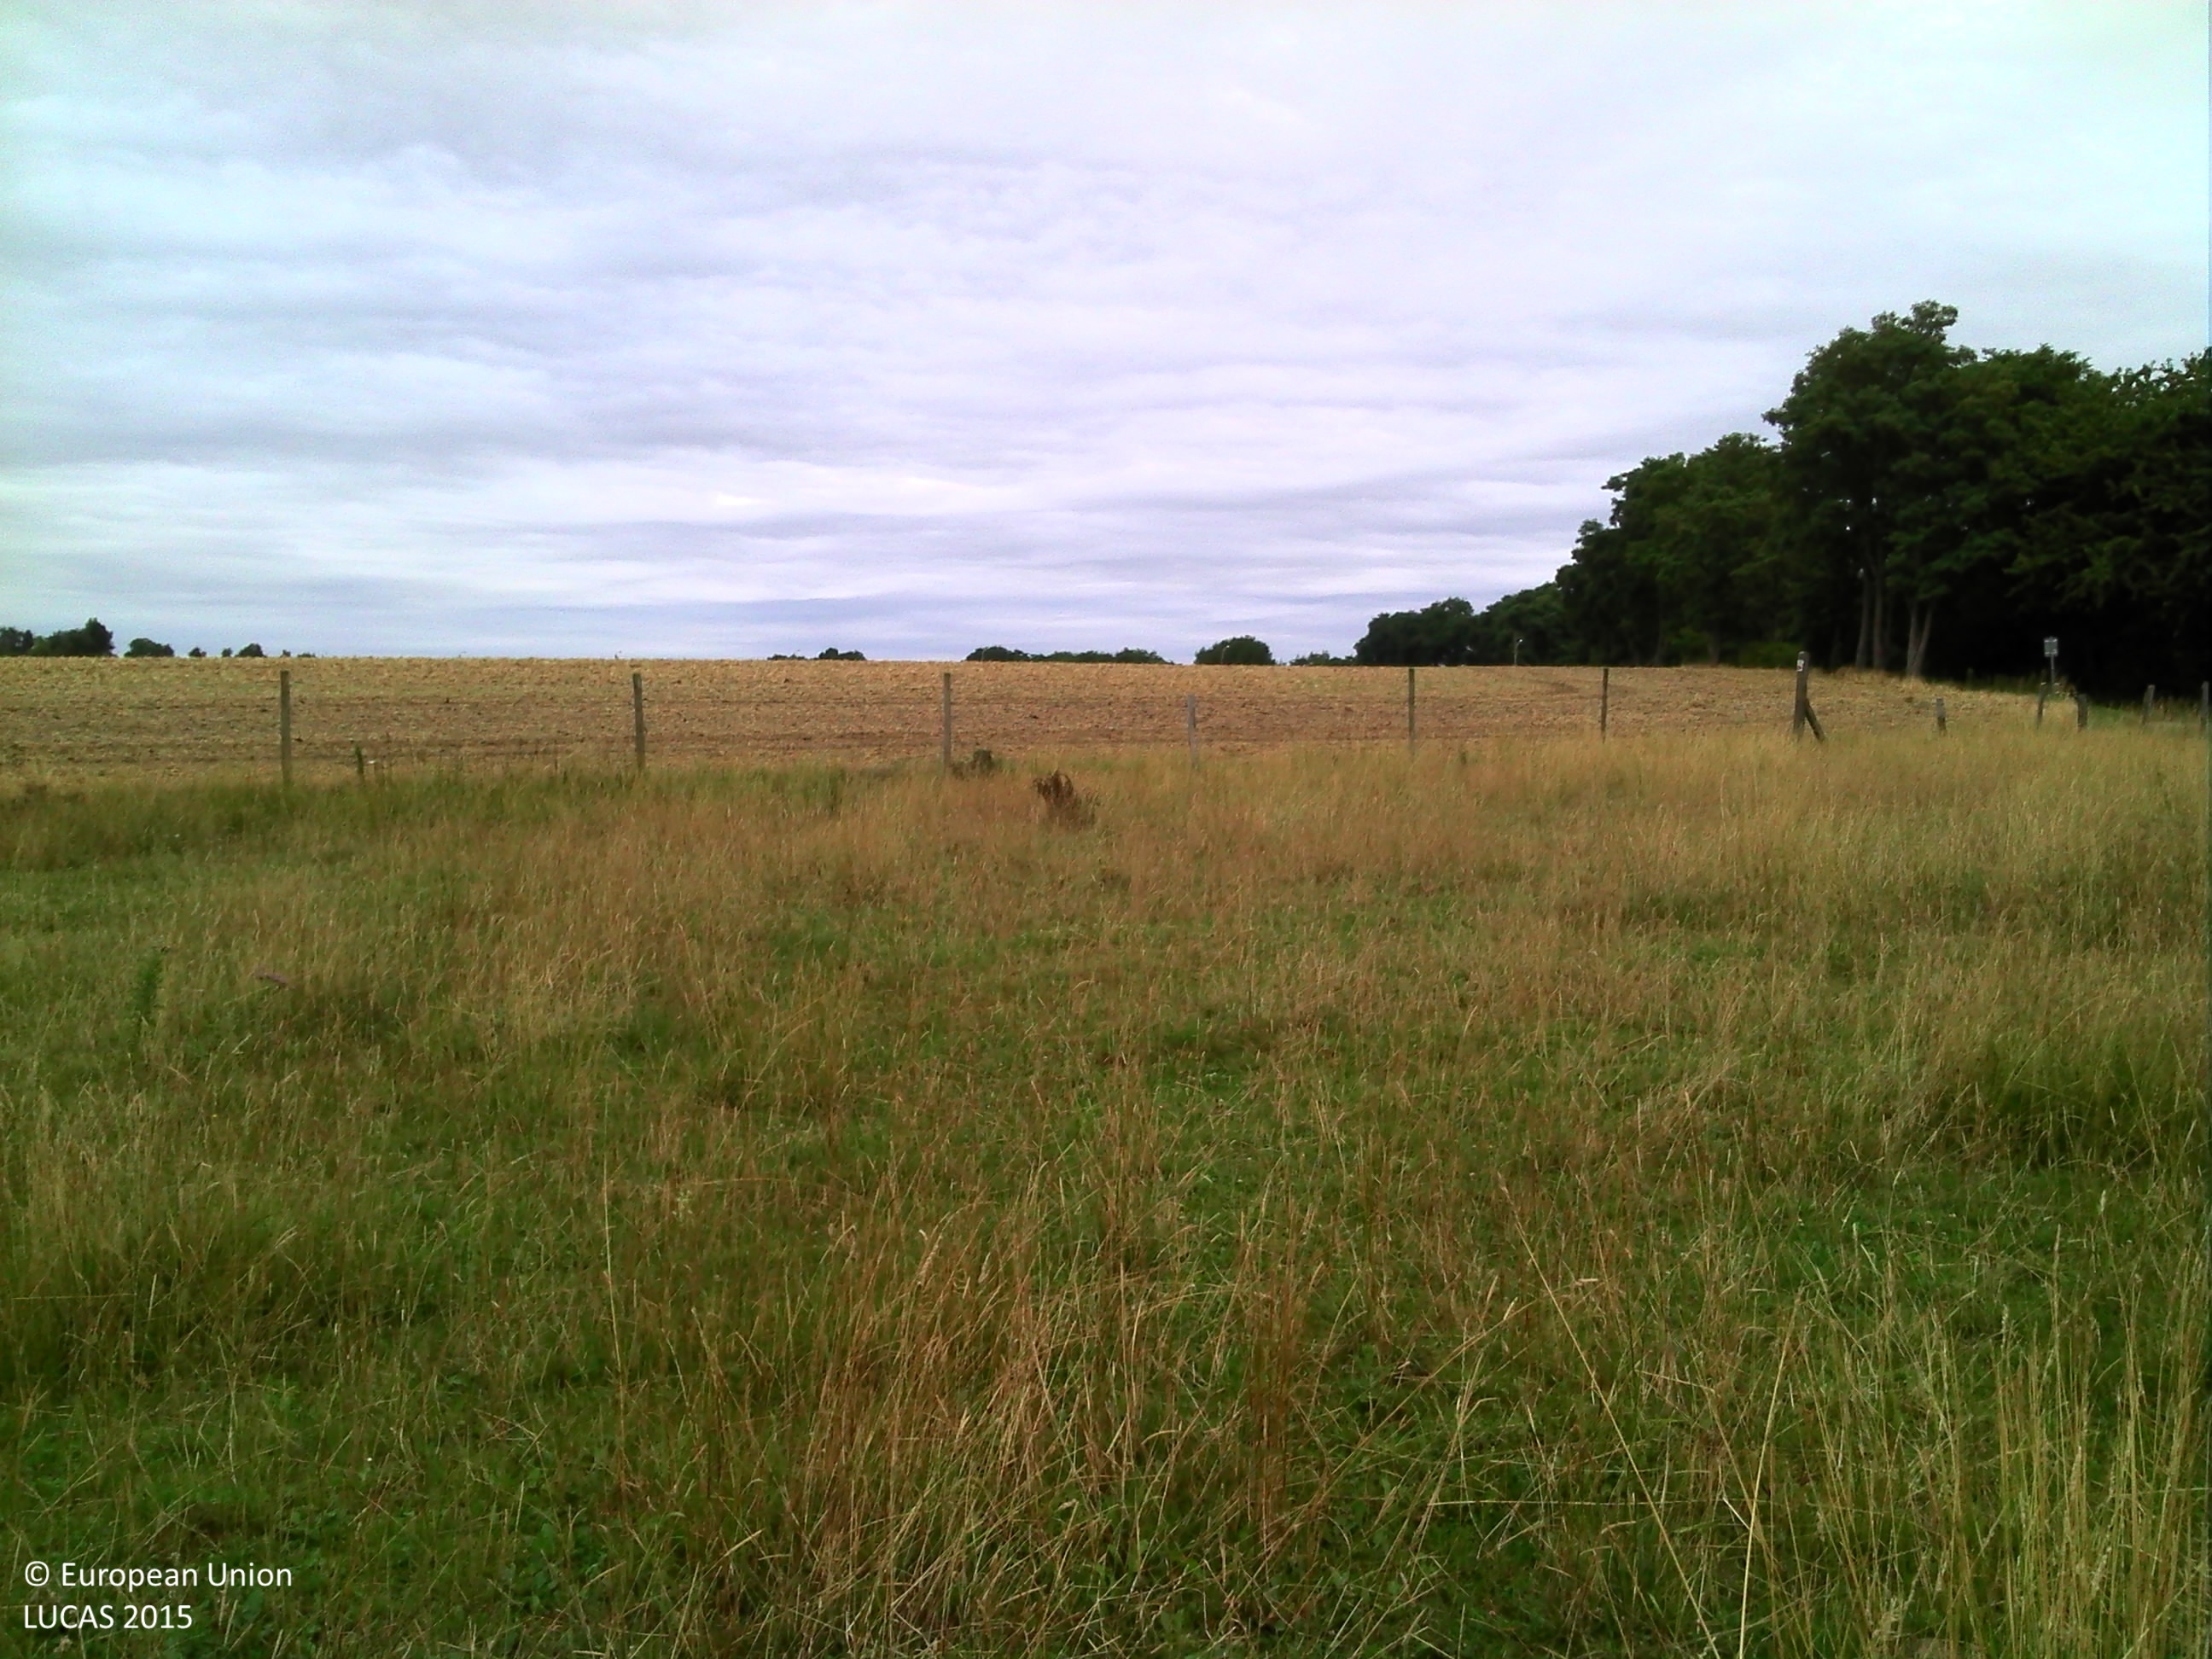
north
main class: Grassland
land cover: Grassland with sparse tree/shrub cover
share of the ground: > 75 %
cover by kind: herbaceous plants 95 %, broadleaved forest trees 5 %
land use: Agriculture (excluding fallow land and kitchen gardens)
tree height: > 5 m
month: July
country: BE
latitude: 50.7304
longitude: 5.6206
